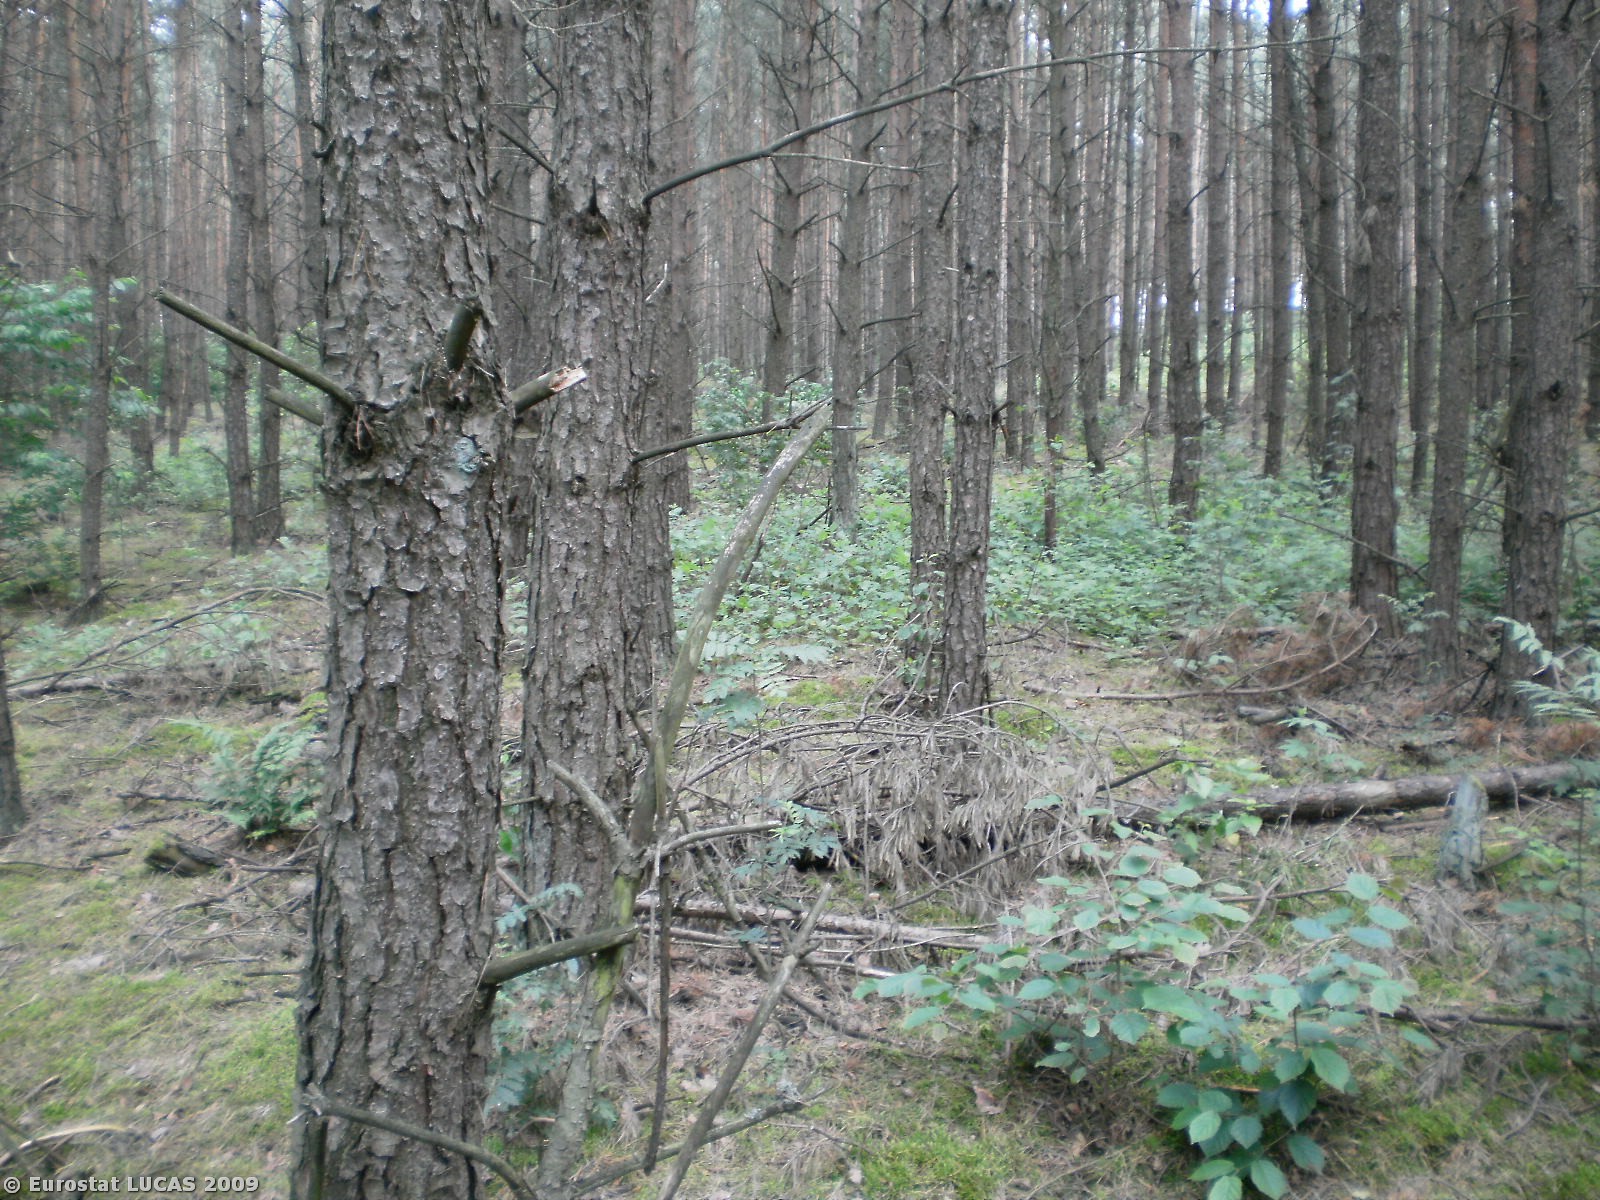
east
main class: Woodland
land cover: Coniferous woodland
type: hemiboreal forest and nemoral coniferous forest and mixed broadleaved-coniferous forest
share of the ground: > 75 %
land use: Forestry
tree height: > 5 m
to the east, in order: Coniferous woodland
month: July
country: PL
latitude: 52.9697
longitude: 20.4152
